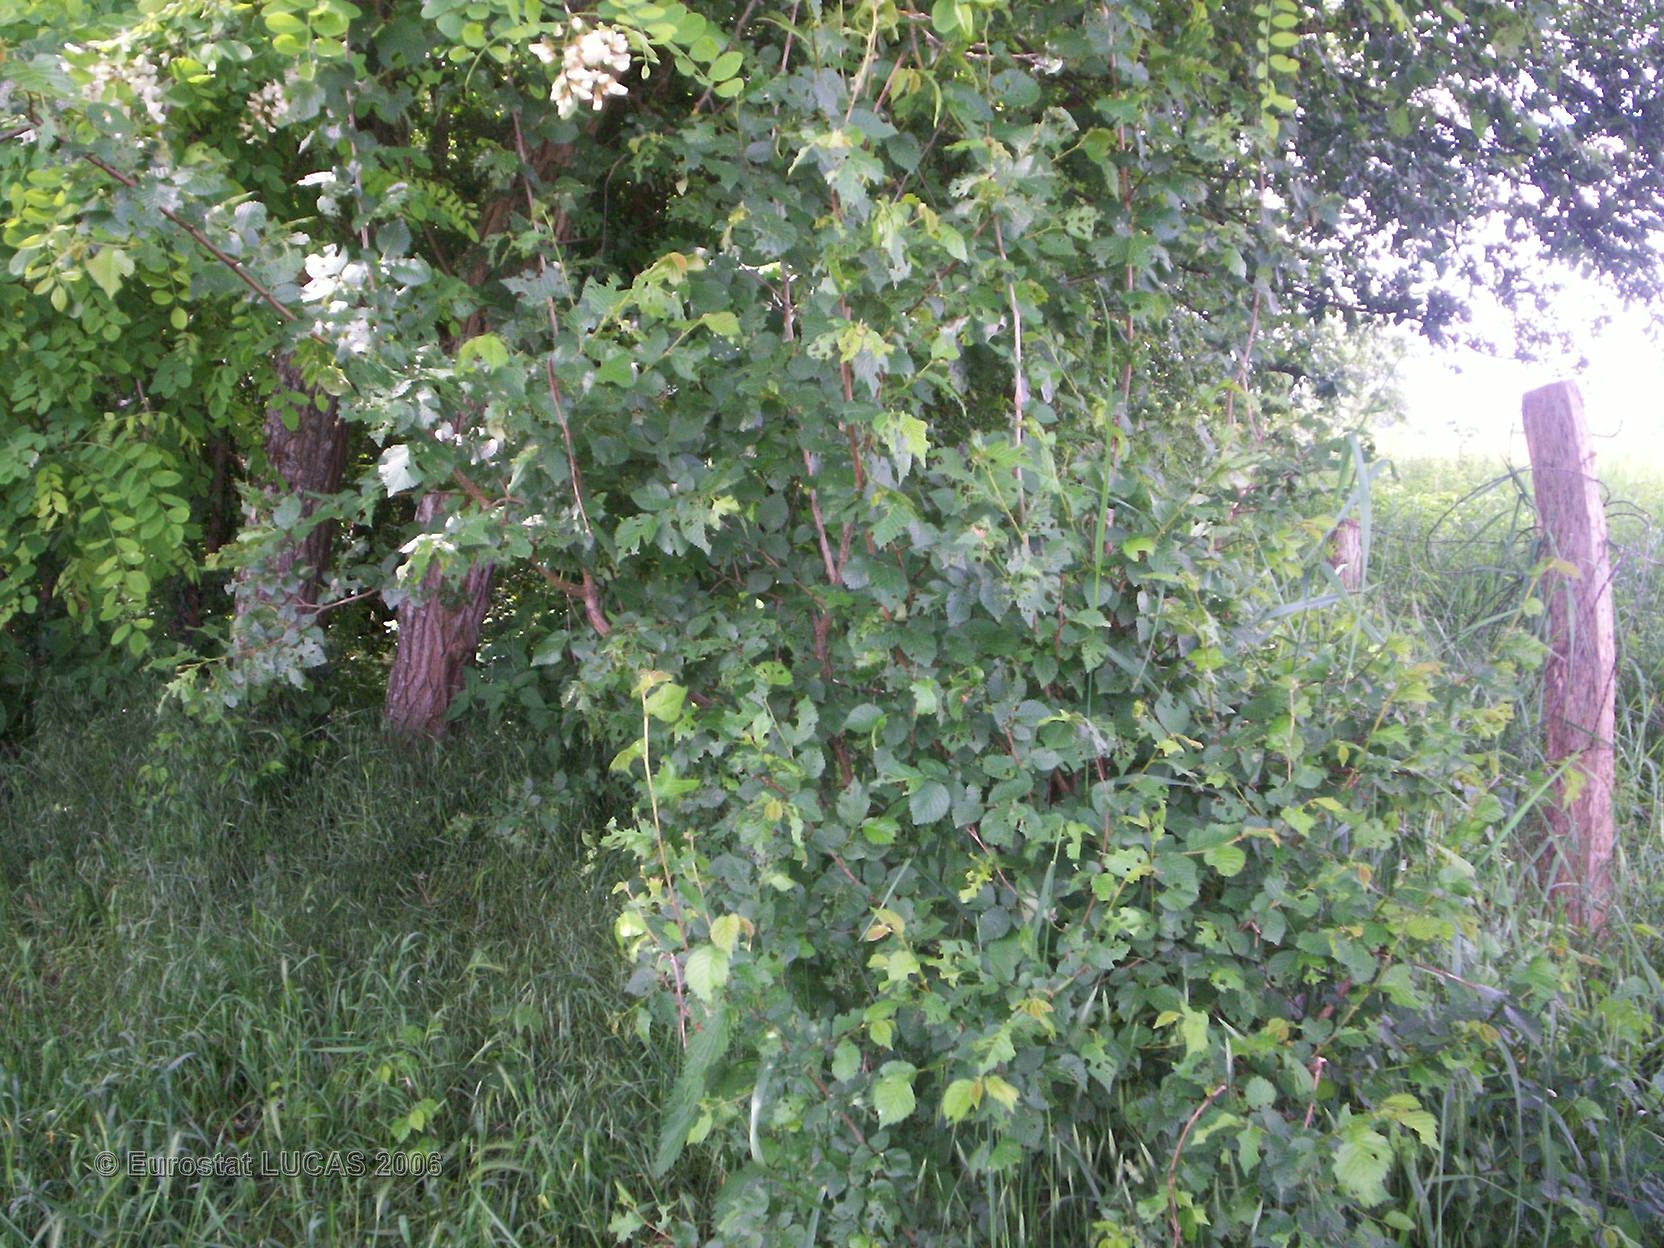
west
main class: Grassland
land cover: Grassland without tree/shrub cover
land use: Agriculture (excluding fallow land and kitchen gardens)
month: May
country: FR
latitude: 47.0473
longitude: 3.0590
